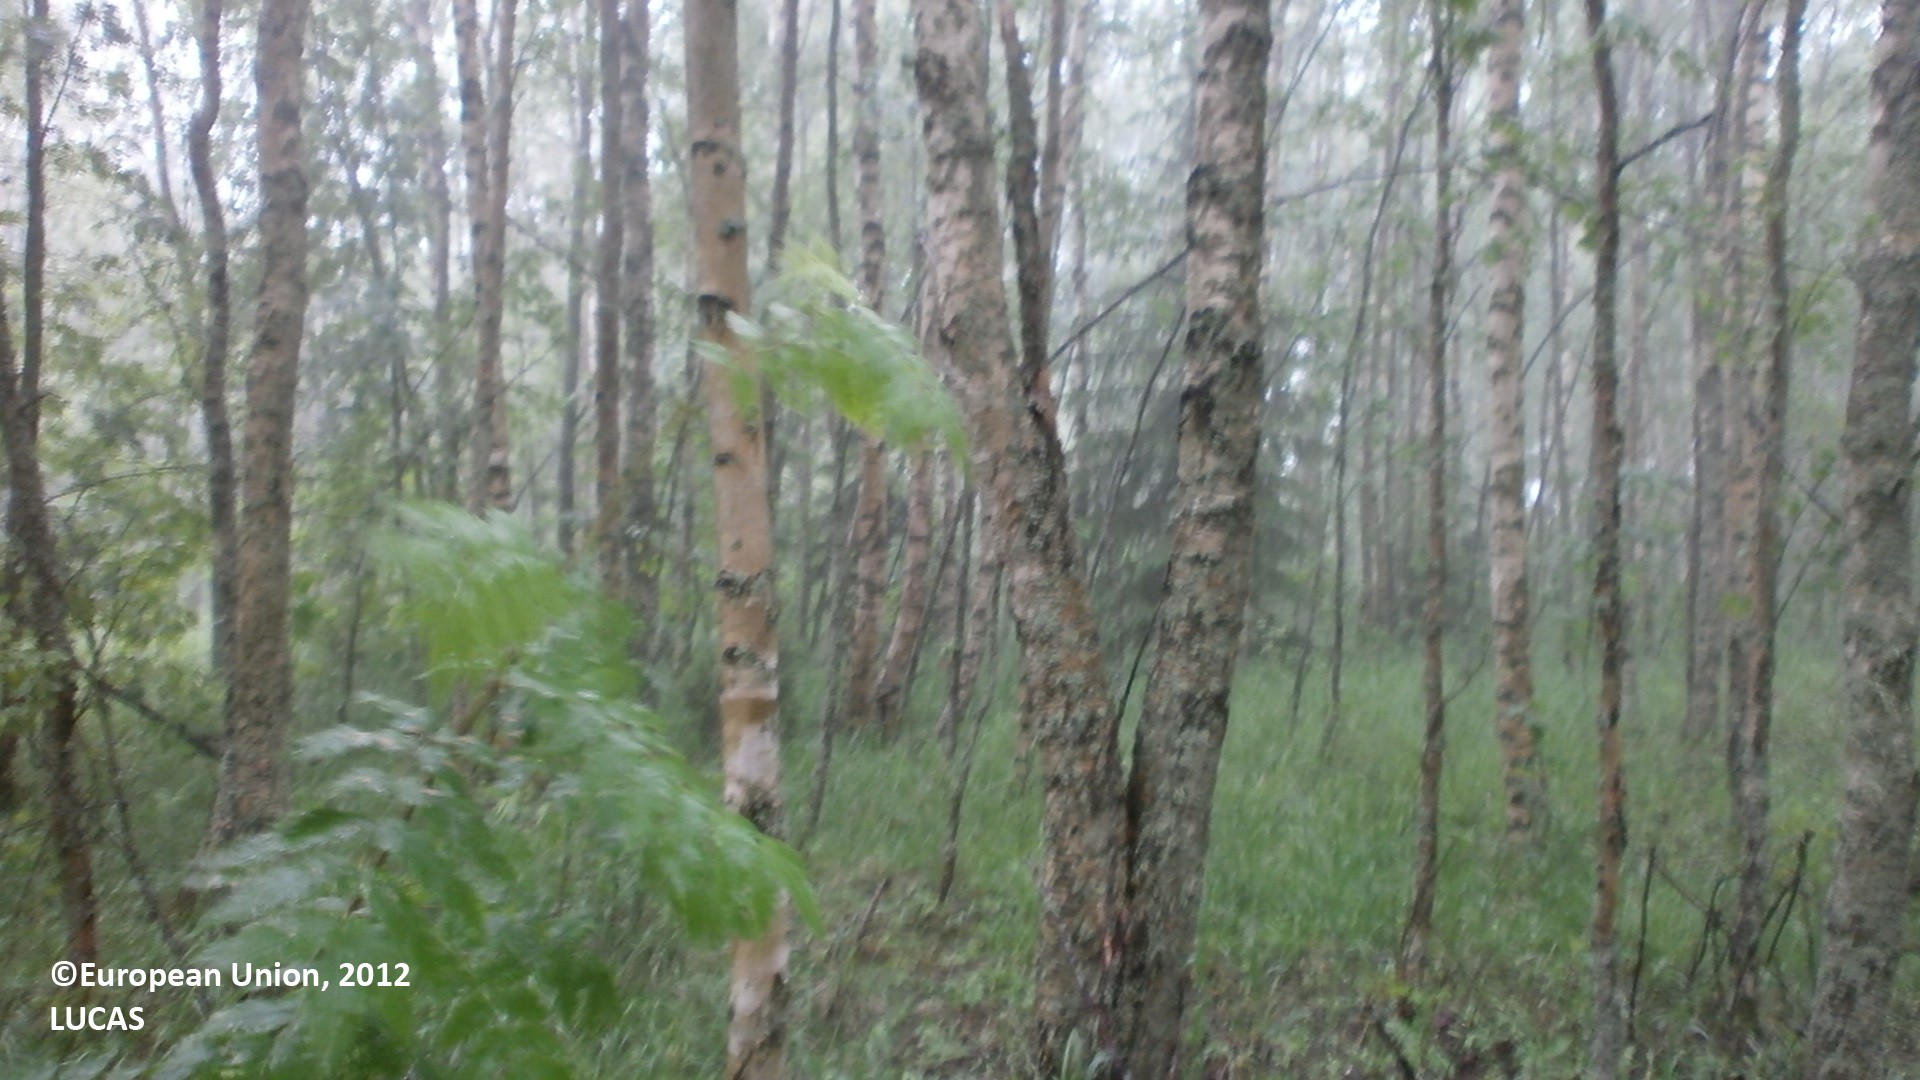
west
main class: Woodland
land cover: Broadleaved woodland
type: boreal forest
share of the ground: 50 - 75 %
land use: Forestry
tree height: > 5 m
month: June
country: FI
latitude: 64.8387
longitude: 25.2363
